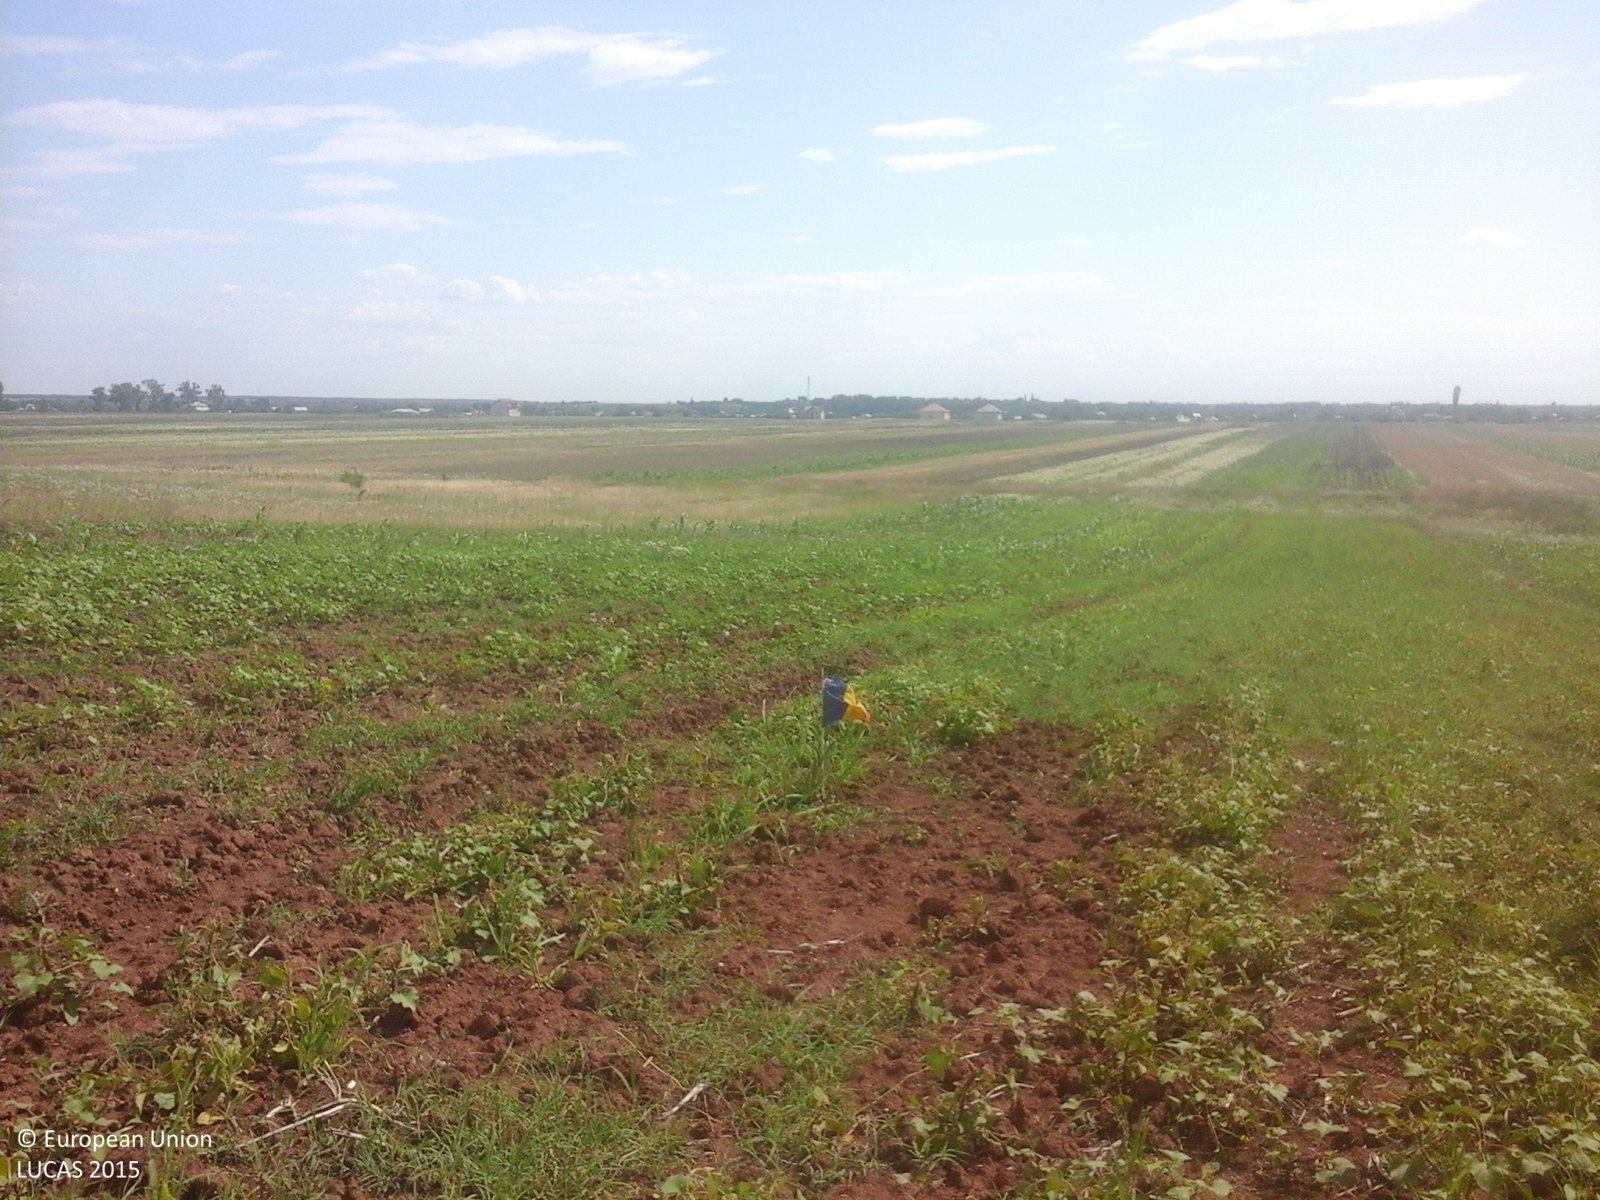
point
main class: Cropland
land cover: Other cereals
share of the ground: < 10 %
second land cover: Spontaneously vegetated surfaces
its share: < 10 %
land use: Agriculture (excluding fallow land and kitchen gardens)
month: July
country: RO
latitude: 44.4490
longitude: 25.4586
